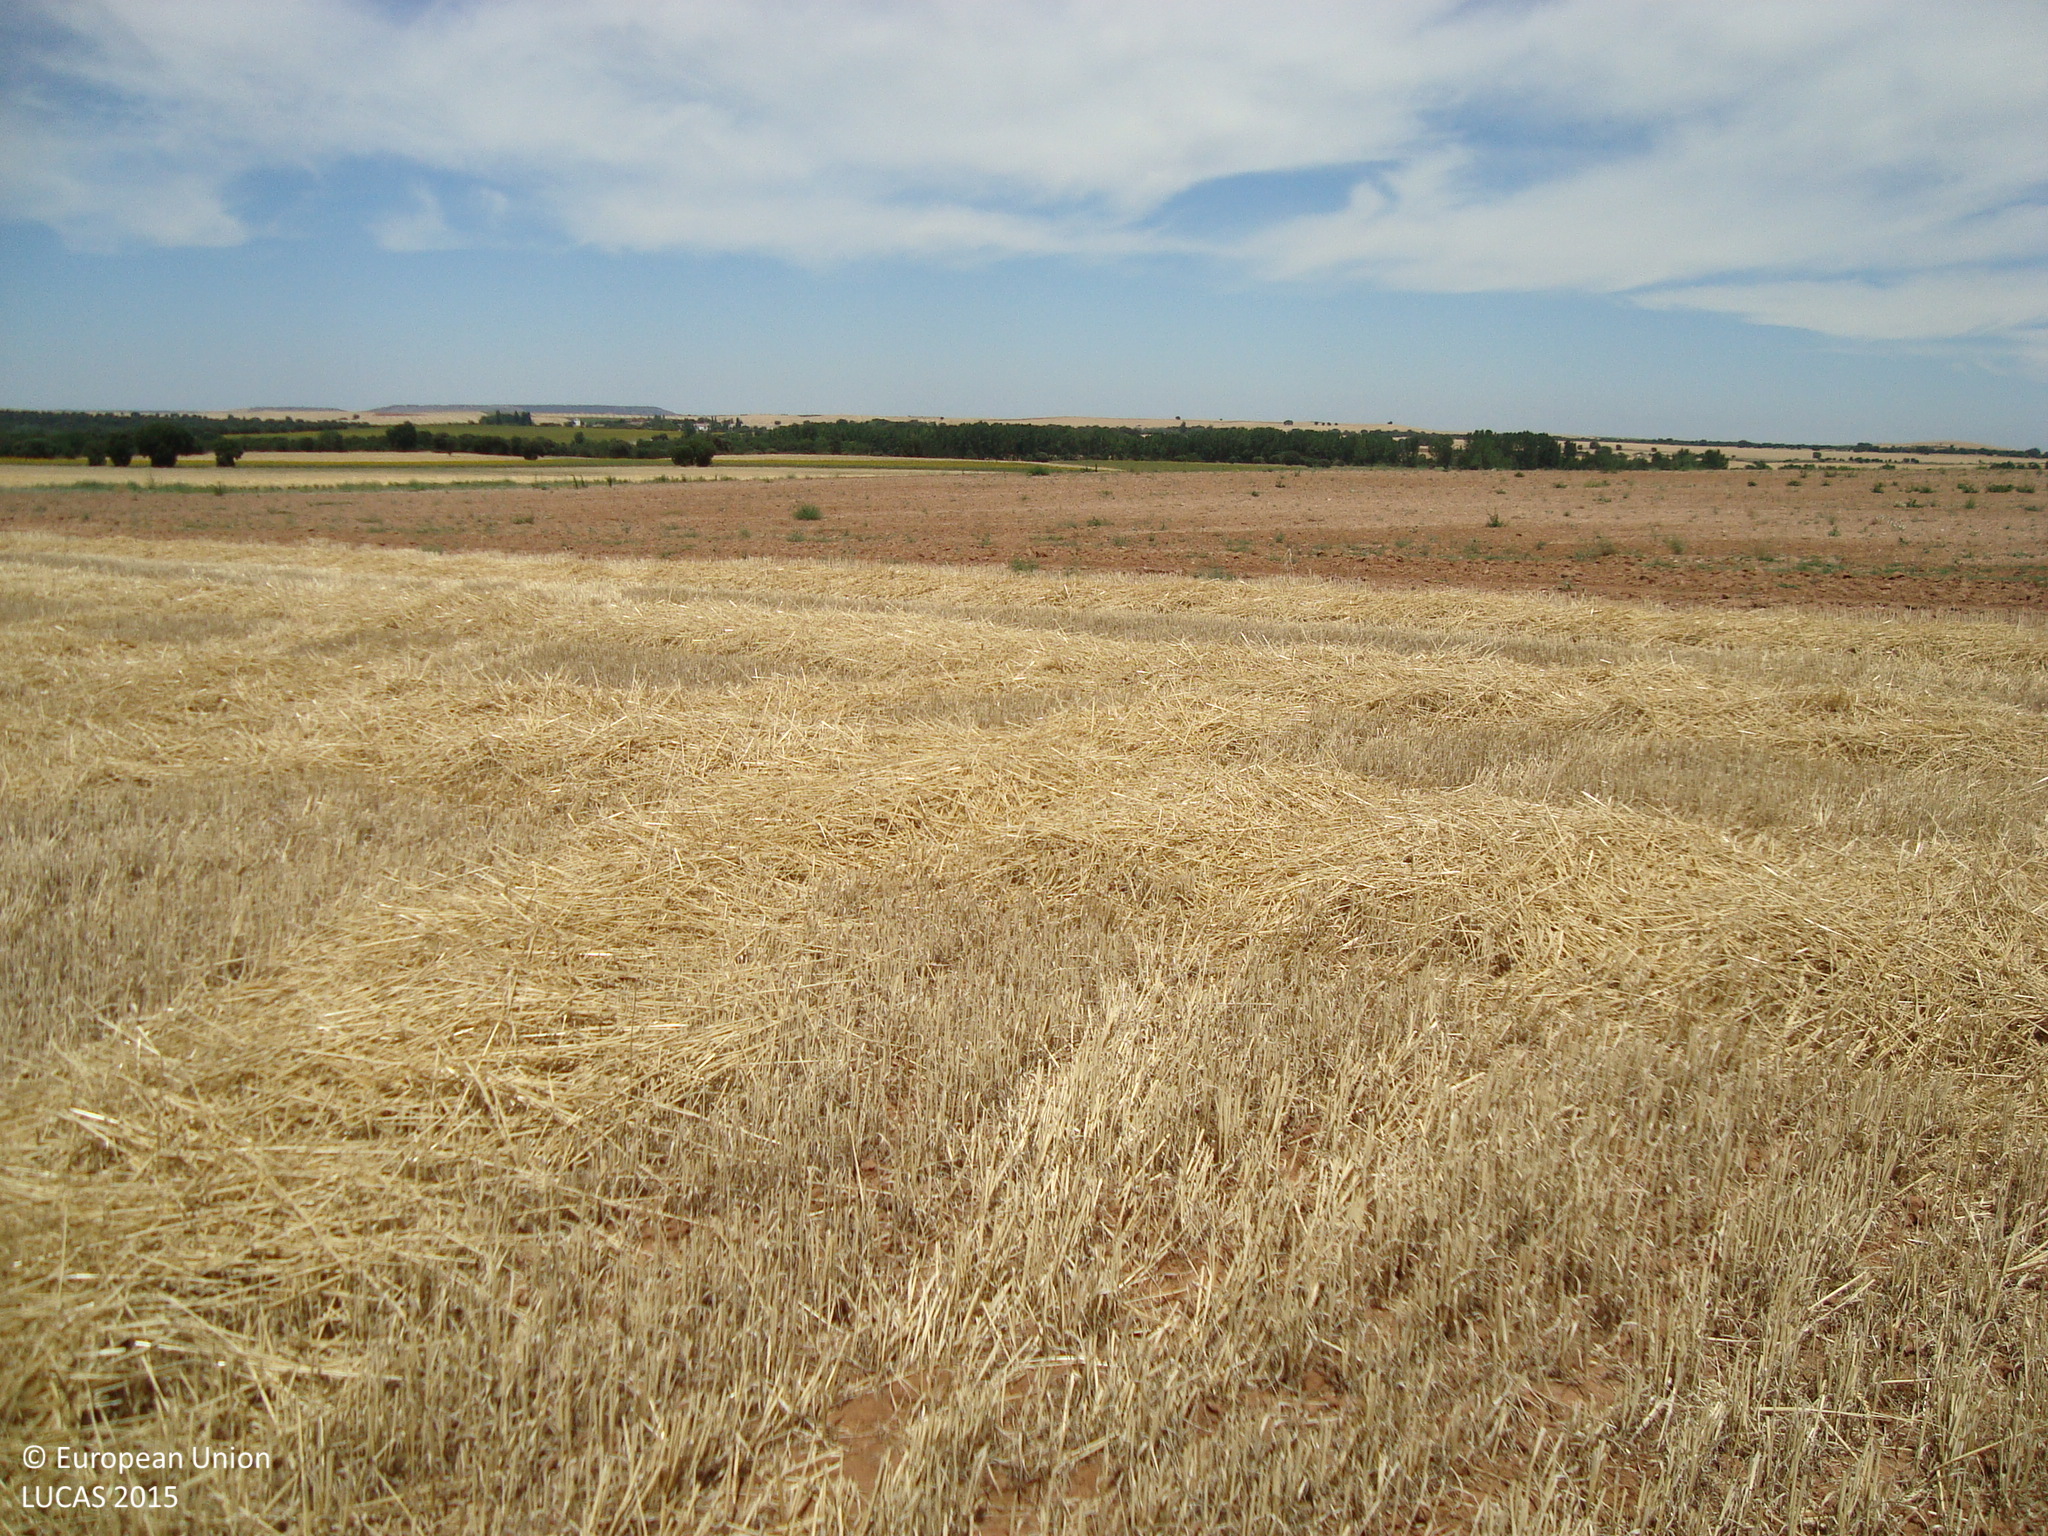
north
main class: Cropland
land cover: Common wheat
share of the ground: > 75 %
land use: Agriculture (excluding fallow land and kitchen gardens)
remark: Harvested field
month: July
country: ES
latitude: 42.0990
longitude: -3.8567
